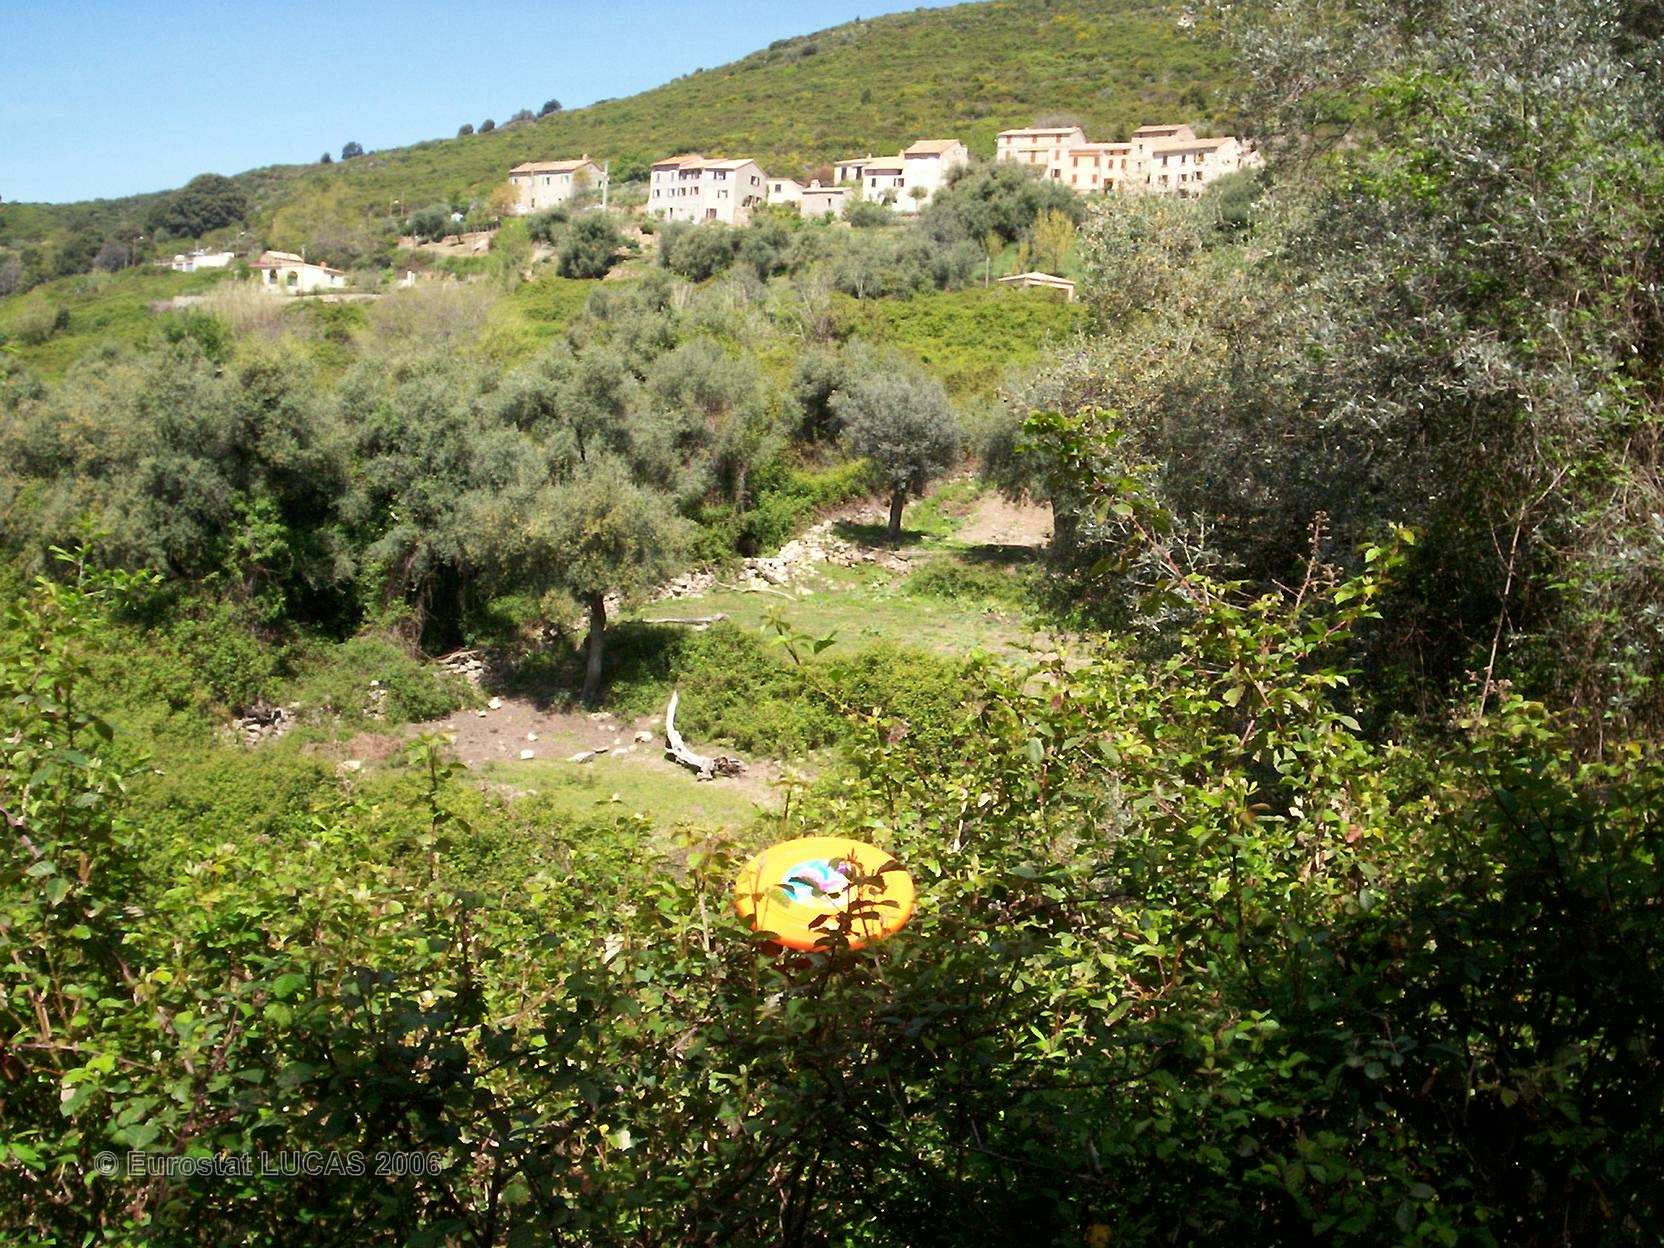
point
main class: Cropland
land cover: Olive groves
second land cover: Shrubland with sparse tree cover
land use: Unused
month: April
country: FR
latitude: 42.1225
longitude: 8.7587
